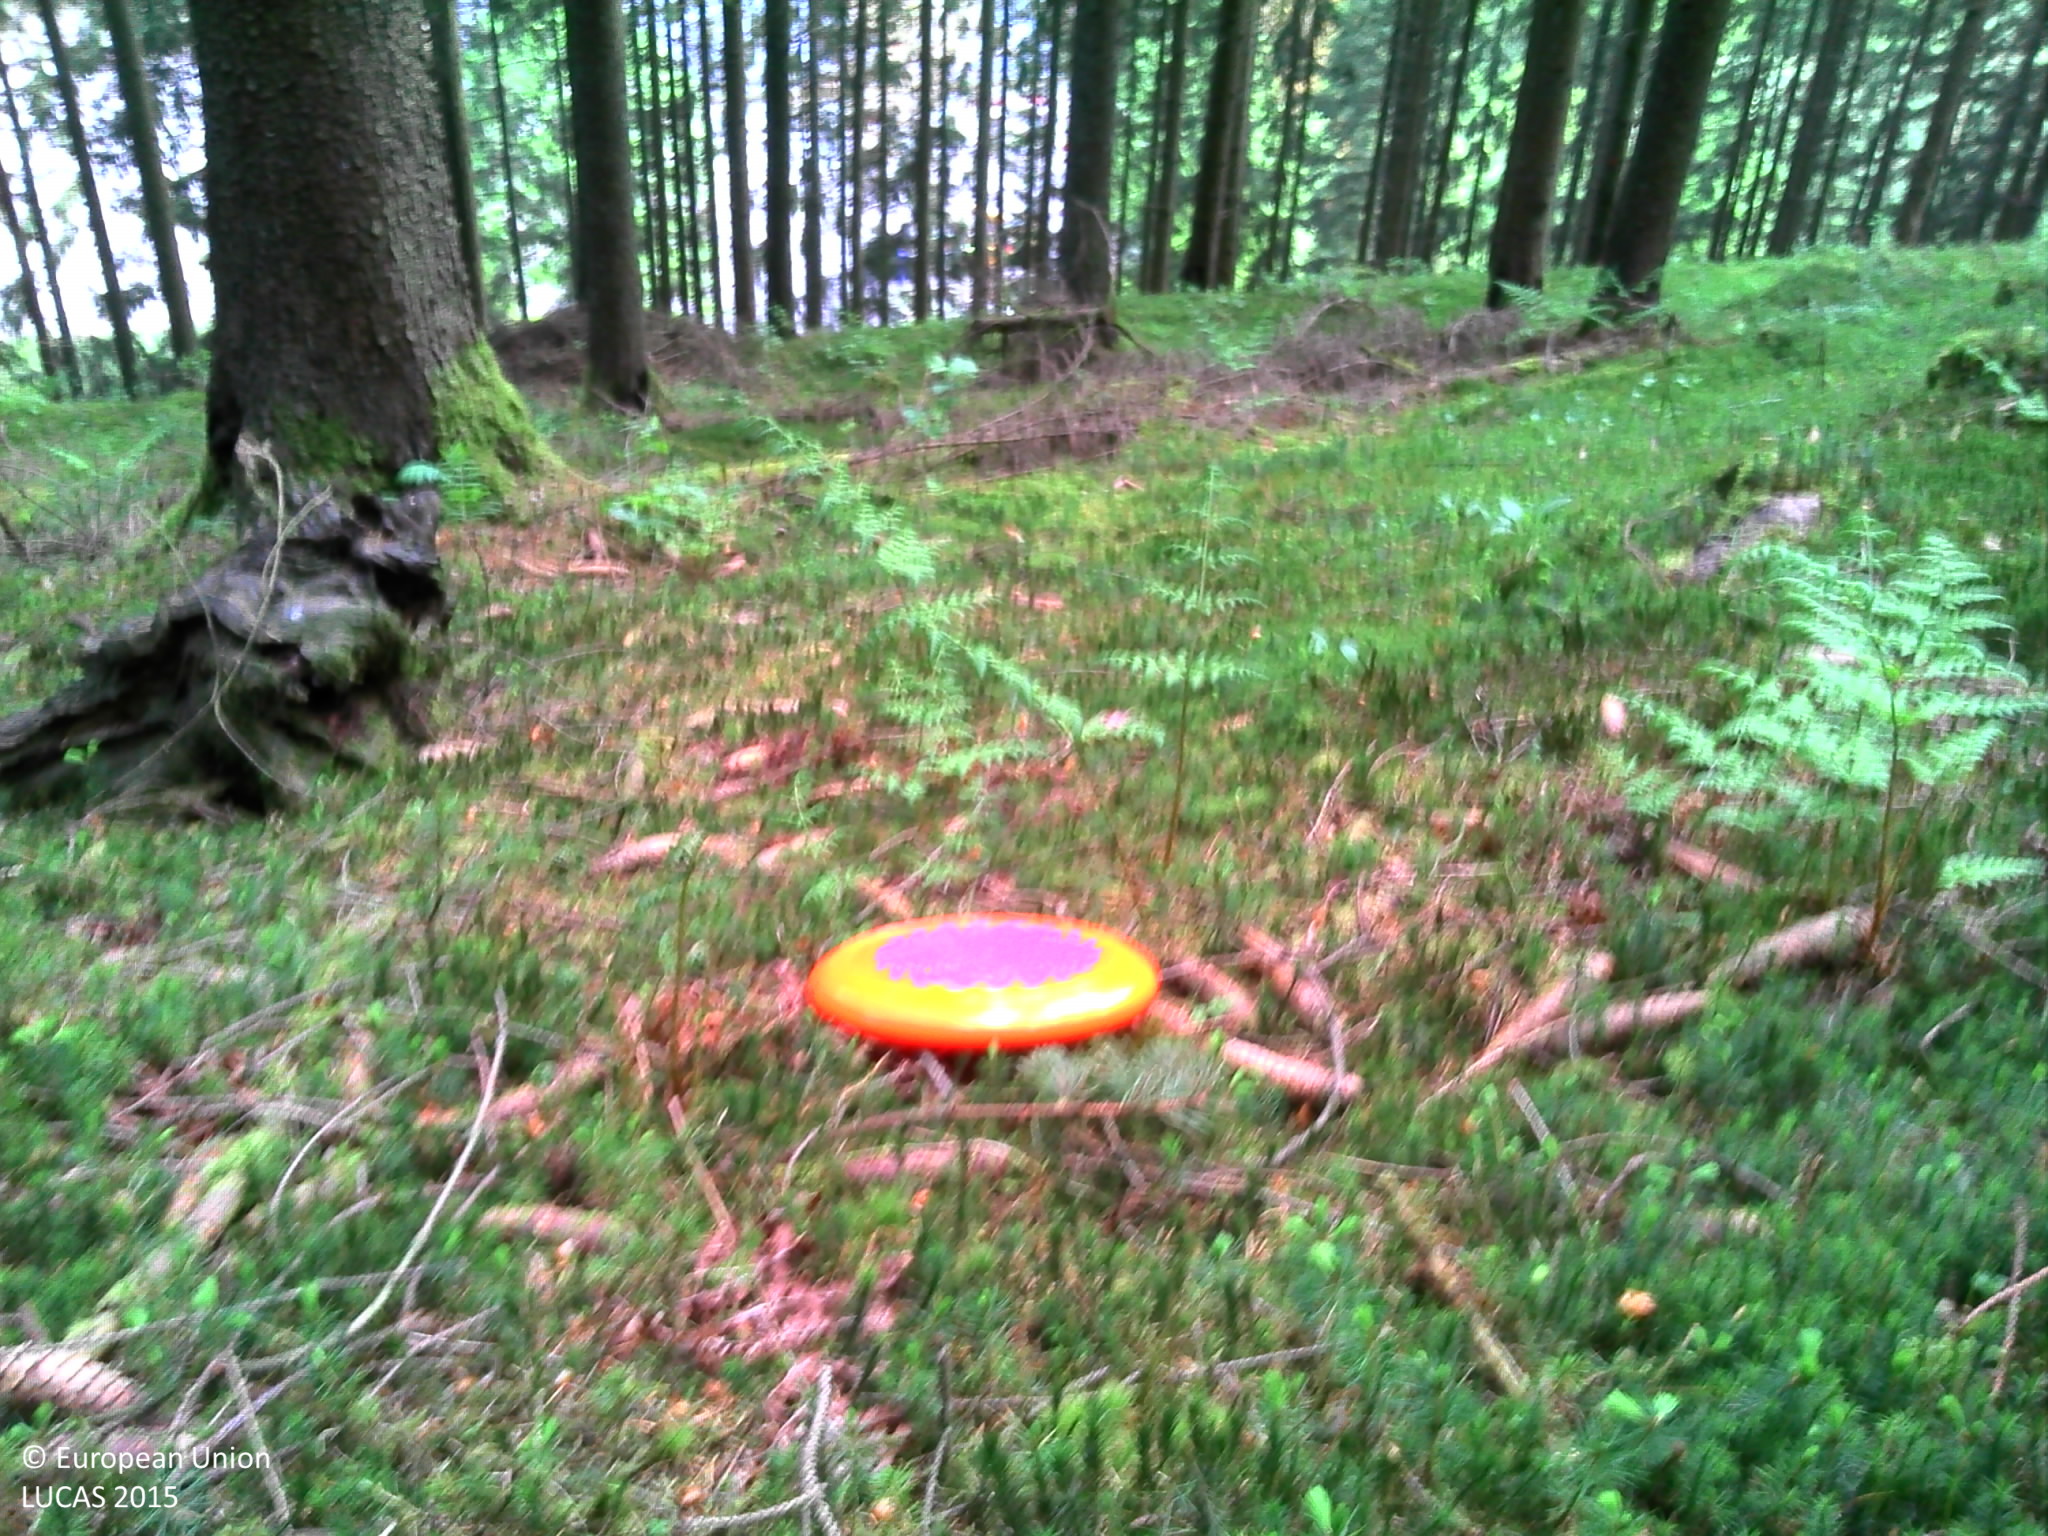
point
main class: Woodland
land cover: Spruce dominated coniferous woodland
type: exotic forest
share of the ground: > 75 %
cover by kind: coniferous forest trees 100 %
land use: Forestry
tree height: > 5 m
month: May
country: LU
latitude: 50.0607
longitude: 6.0180
